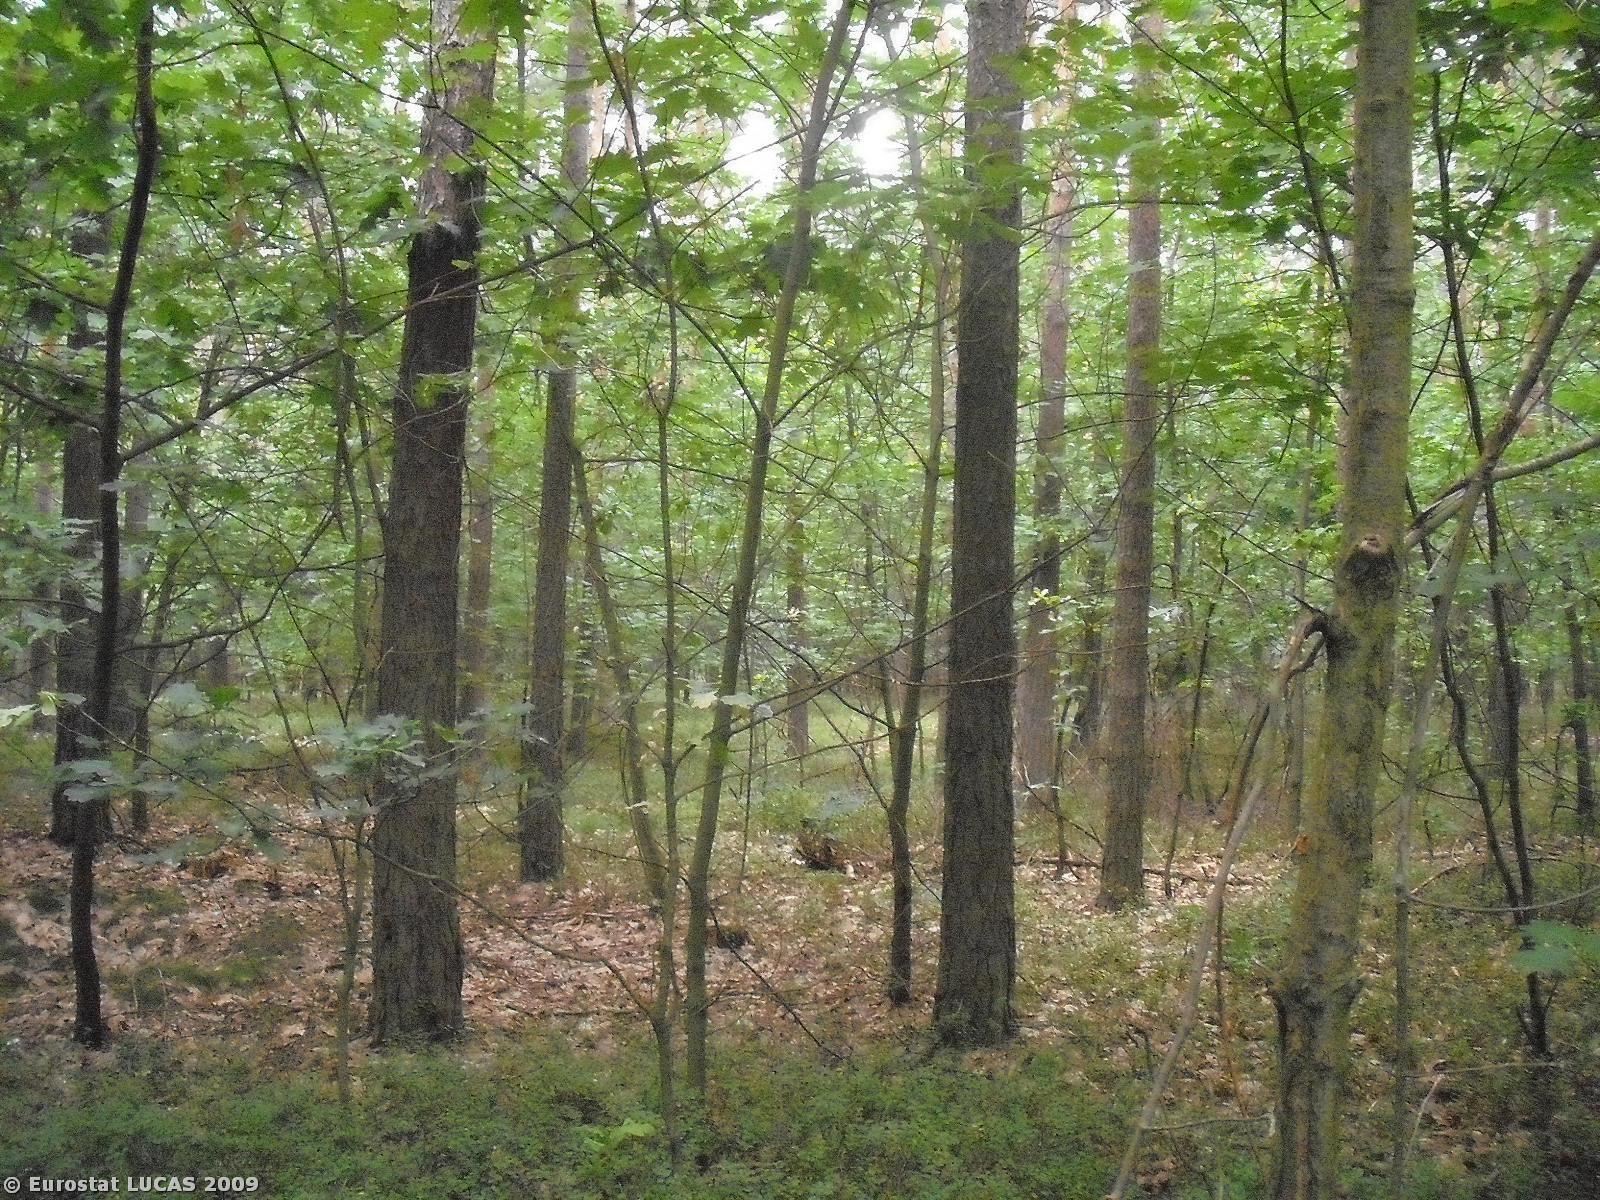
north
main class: Woodland
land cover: Mixed woodland
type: hemiboreal forest and nemoral coniferous forest and mixed broadleaved-coniferous forest
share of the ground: > 75 %
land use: Forestry
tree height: > 5 m
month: August
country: PL
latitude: 51.9565
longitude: 21.1788
